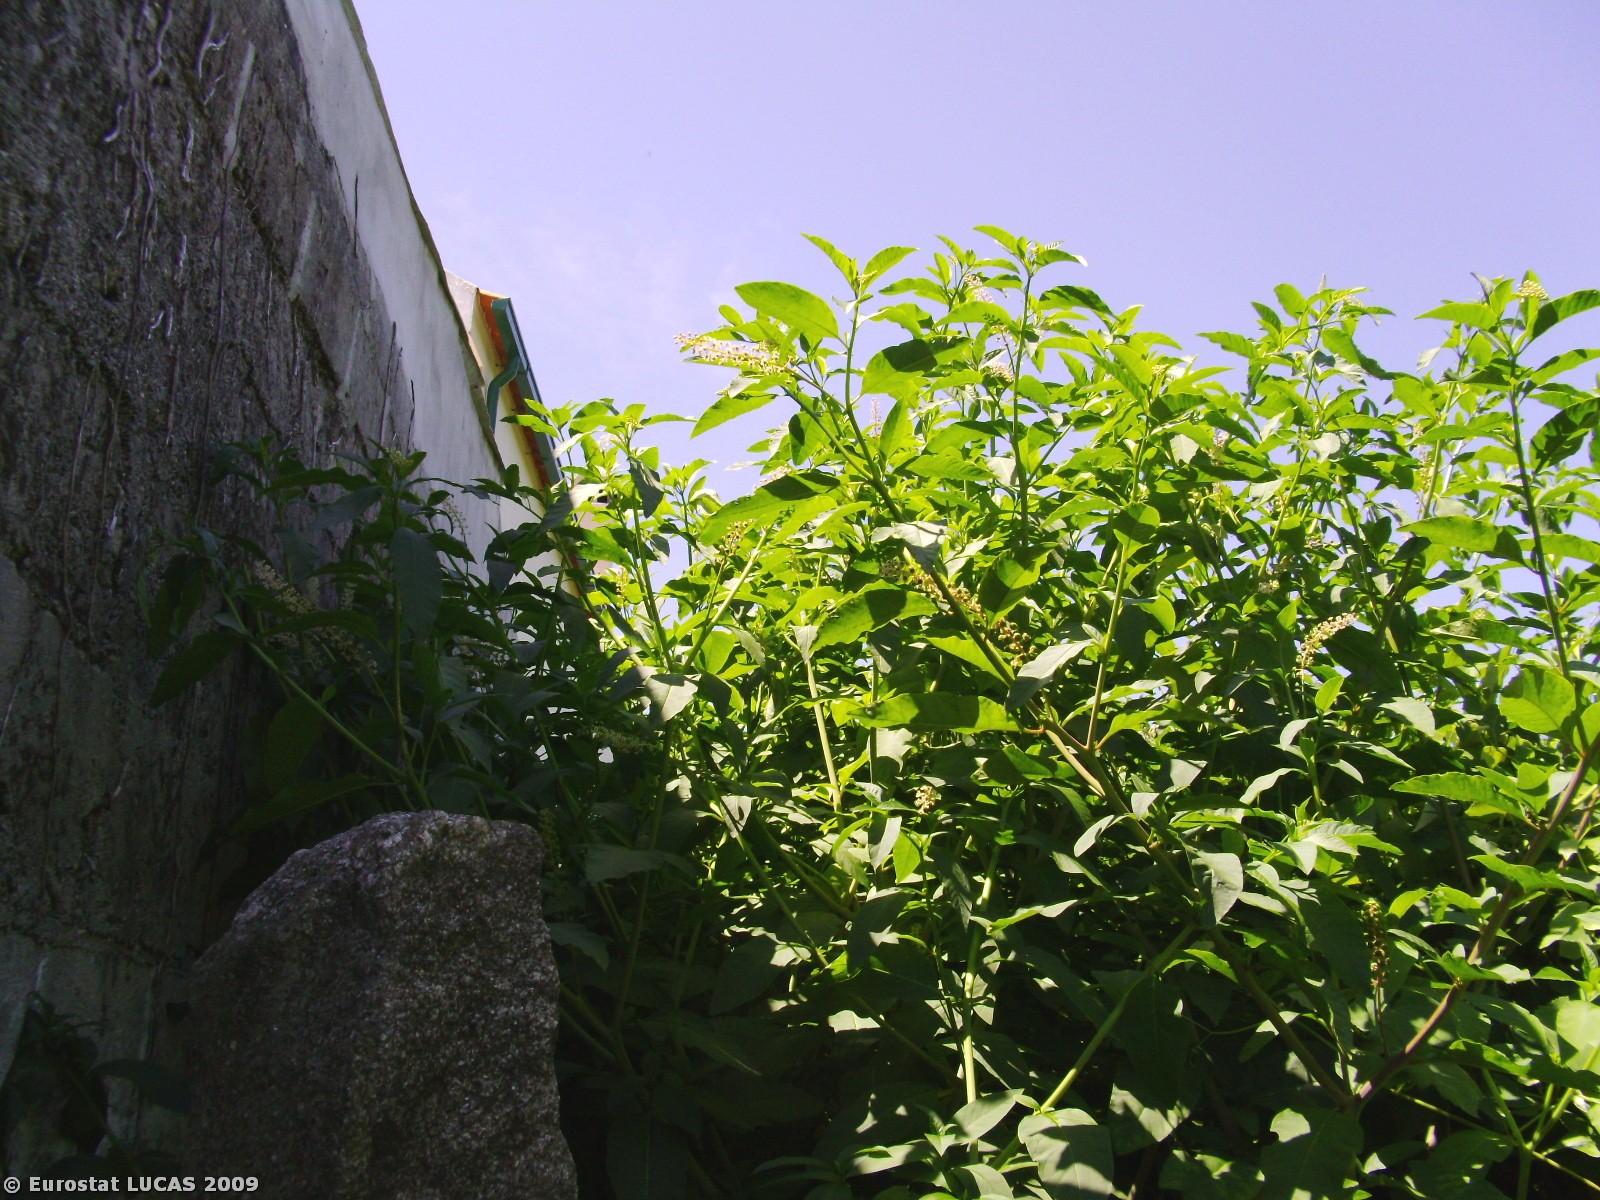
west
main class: Shrubland
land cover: Shrubland with sparse tree cover
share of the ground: > 75 %
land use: Unused
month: July
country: PT
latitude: 41.7100
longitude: -8.7838
